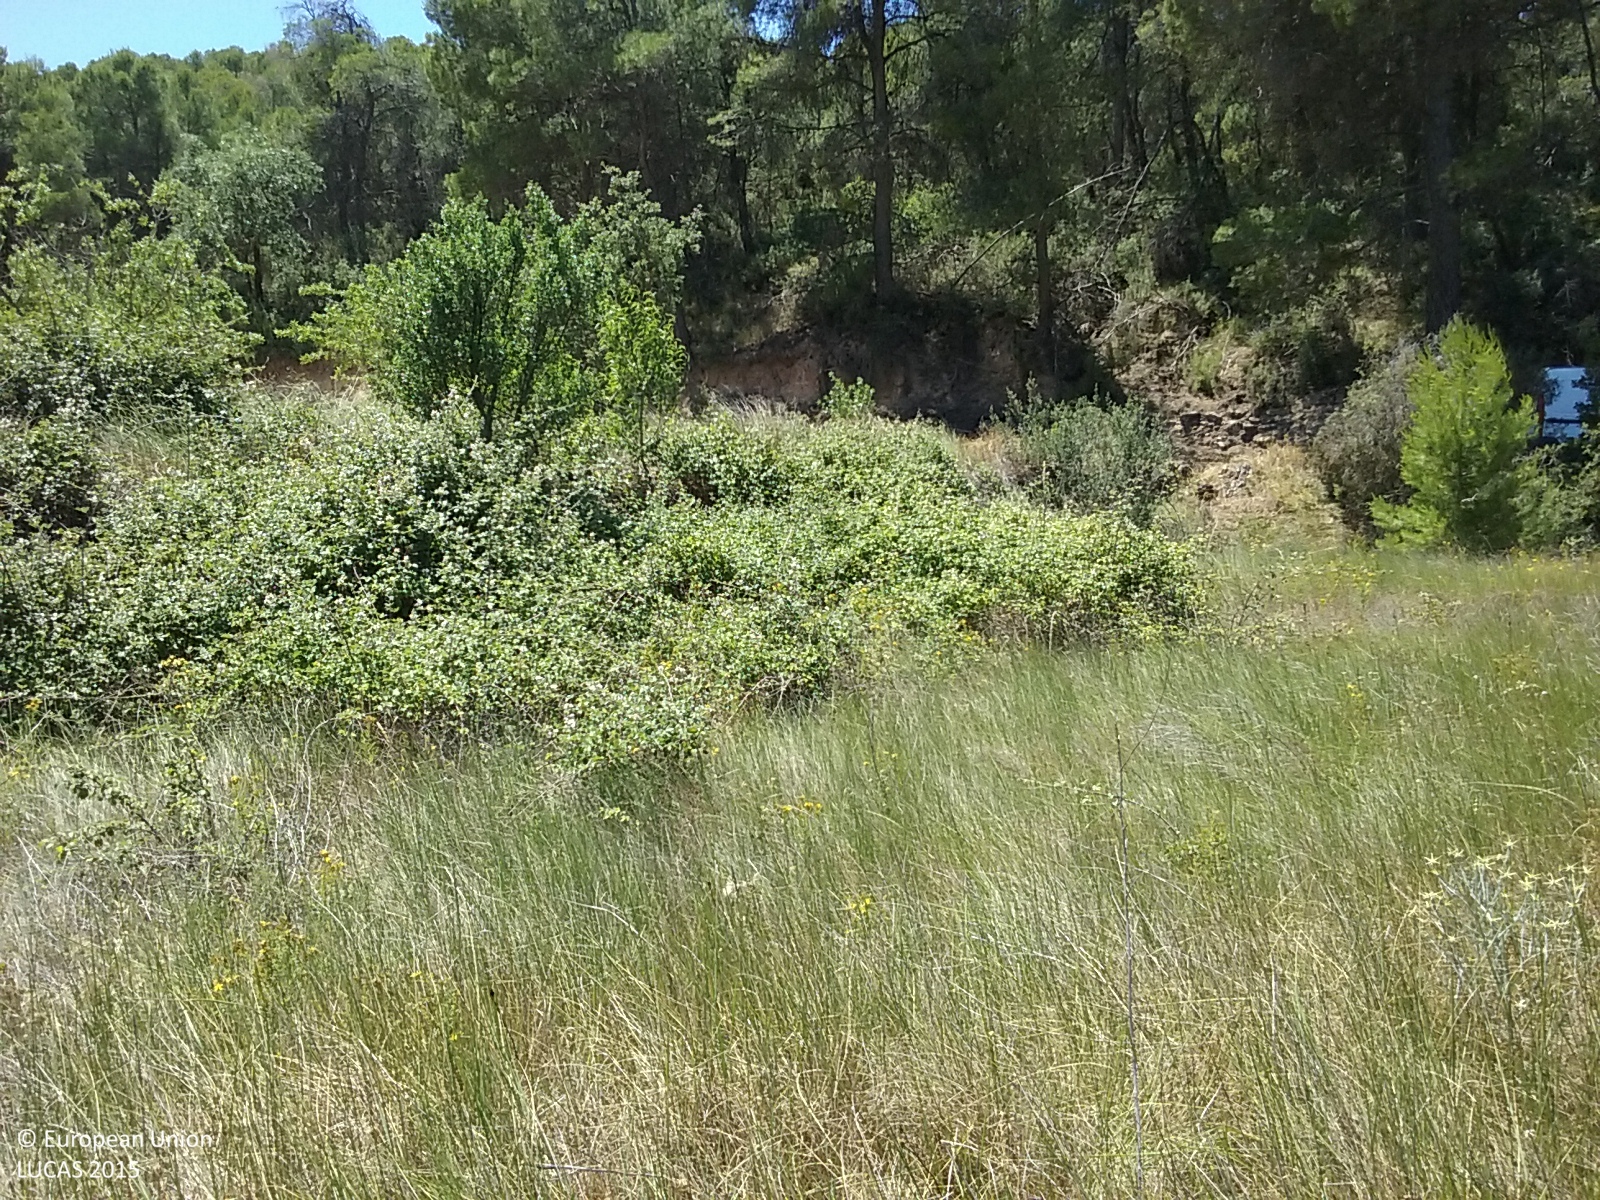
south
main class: Grassland
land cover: Grassland without tree/shrub cover
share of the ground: > 75 %
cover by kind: herbaceous plants 100 %
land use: Abandoned areas
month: June
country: ES
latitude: 41.1713
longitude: 0.3233
